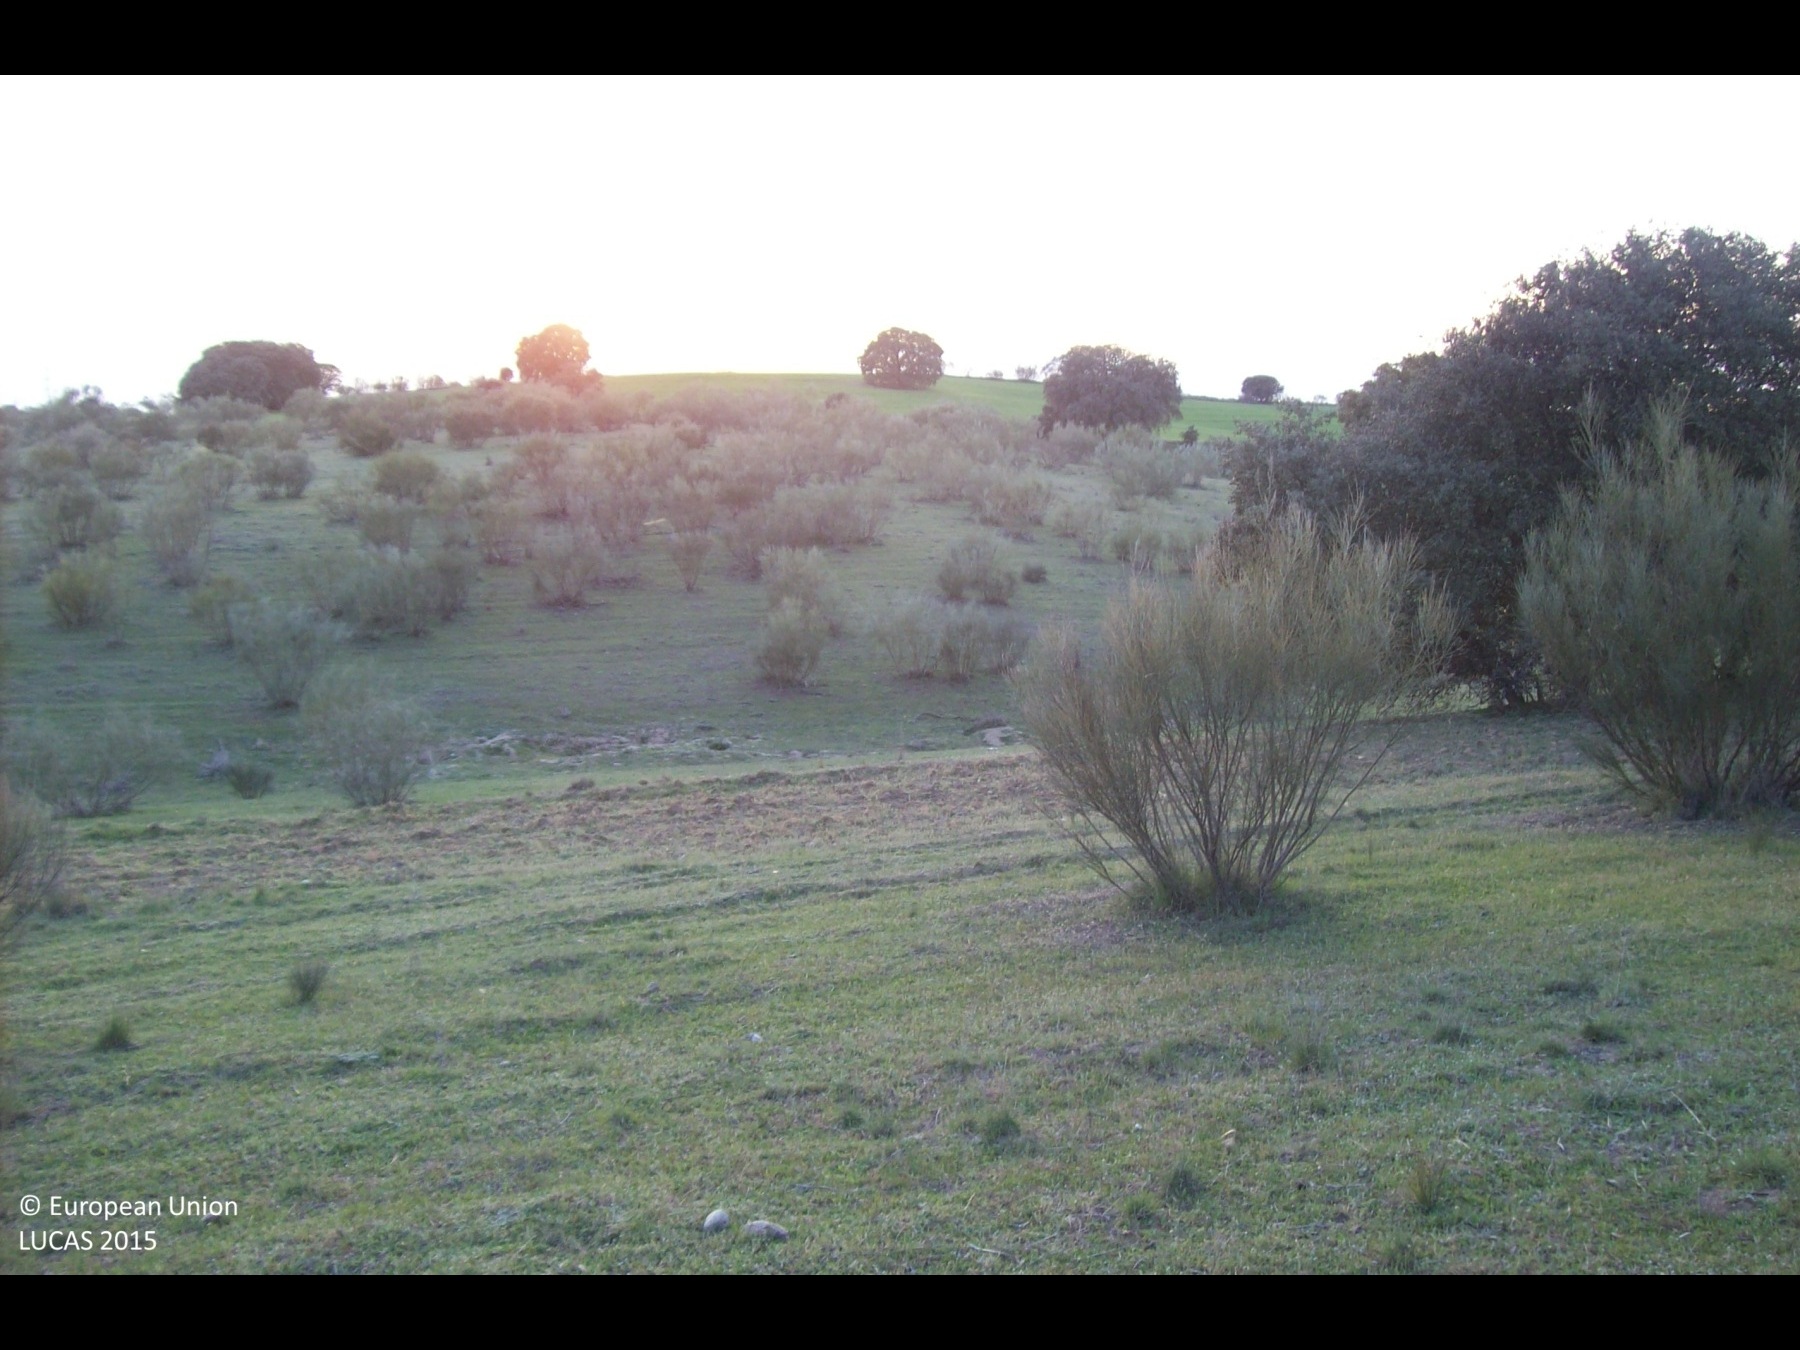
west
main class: Shrubland
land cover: Shrubland without tree cover
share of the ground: 10 - 25 %
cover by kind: herbaceous plants 90 %, shrubs 10 %
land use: Semi-natural and natural areas not in use
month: April
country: ES
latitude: 40.3896
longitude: -3.9056
